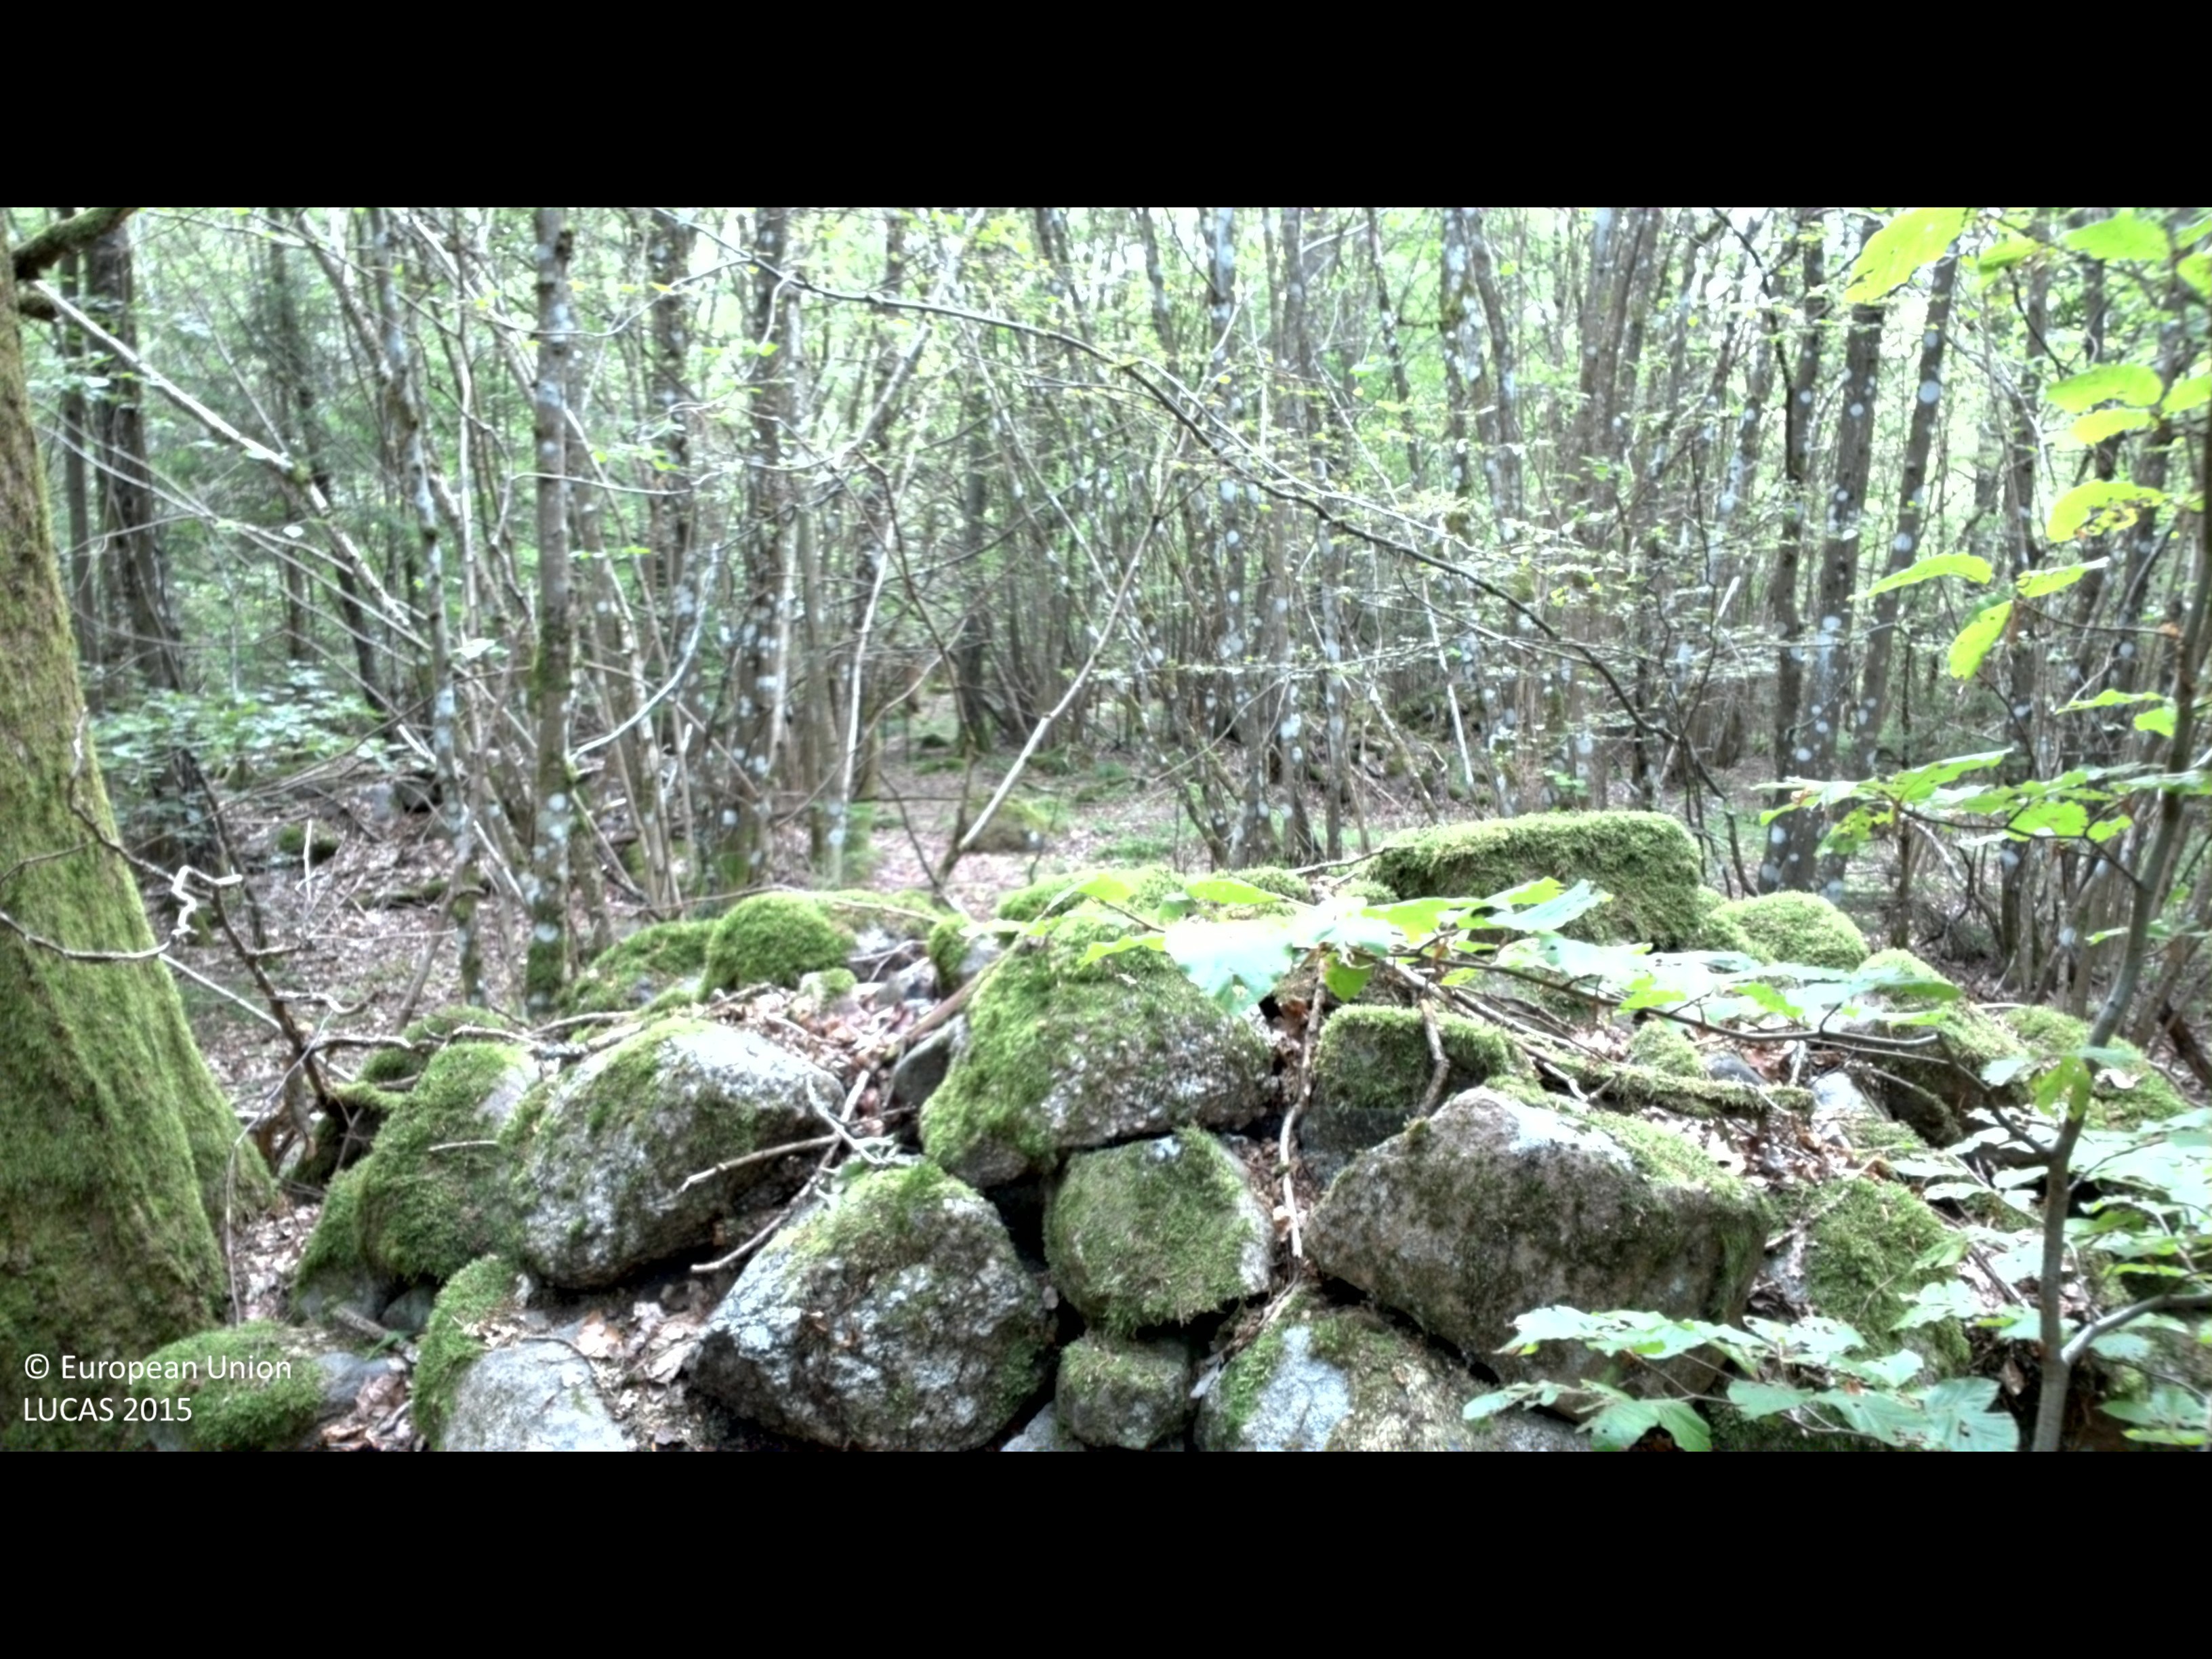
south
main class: Woodland
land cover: Broadleaved woodland
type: mesophytic deciduous forest
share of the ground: 50 - 75 %
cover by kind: broadleaved forest trees 50 %, shrubs 30 %, herbaceous plants 15 %, coniferous forest trees 5 %
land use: Forestry
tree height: > 5 m
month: July
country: SE
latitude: 56.2528
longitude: 15.4387
